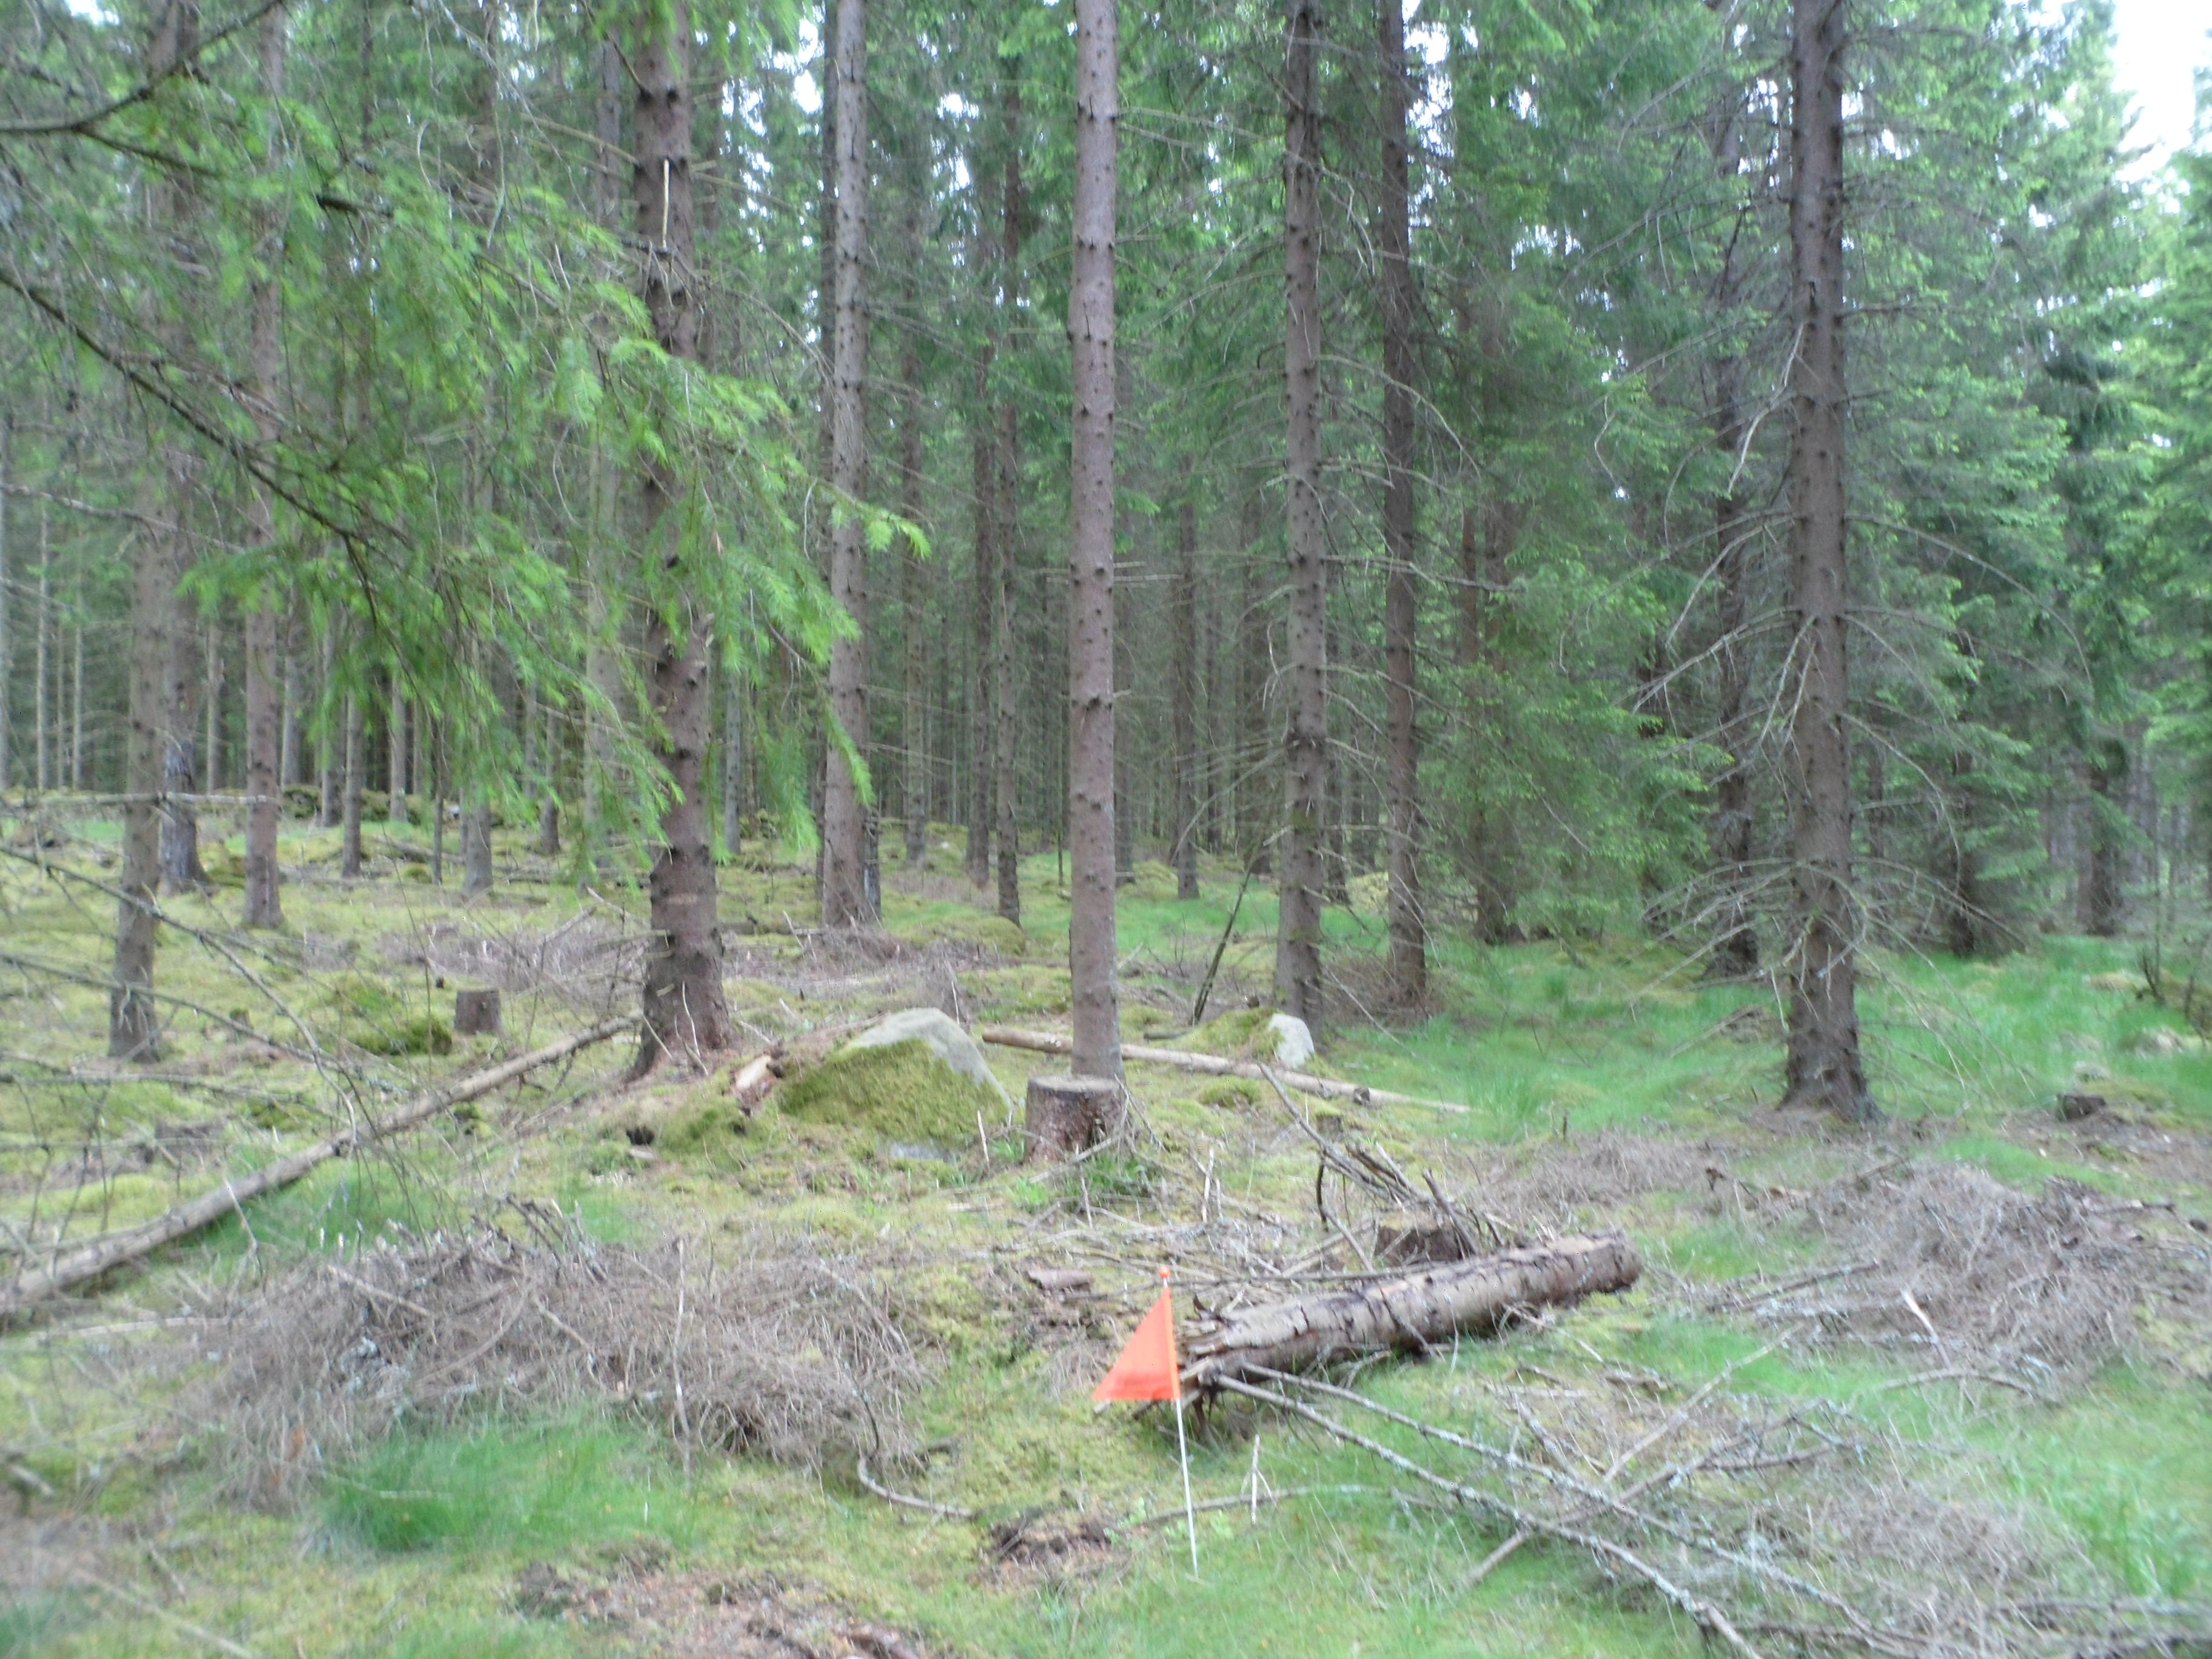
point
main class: Woodland
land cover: Spruce dominated coniferous woodland
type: boreal forest
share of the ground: 50 - 75 %
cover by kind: coniferous forest trees 60 %, lichens and mosses 25 %, herbaceous plants 15 %
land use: Forestry
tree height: > 5 m
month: June
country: SE
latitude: 56.8123
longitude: 14.4687
